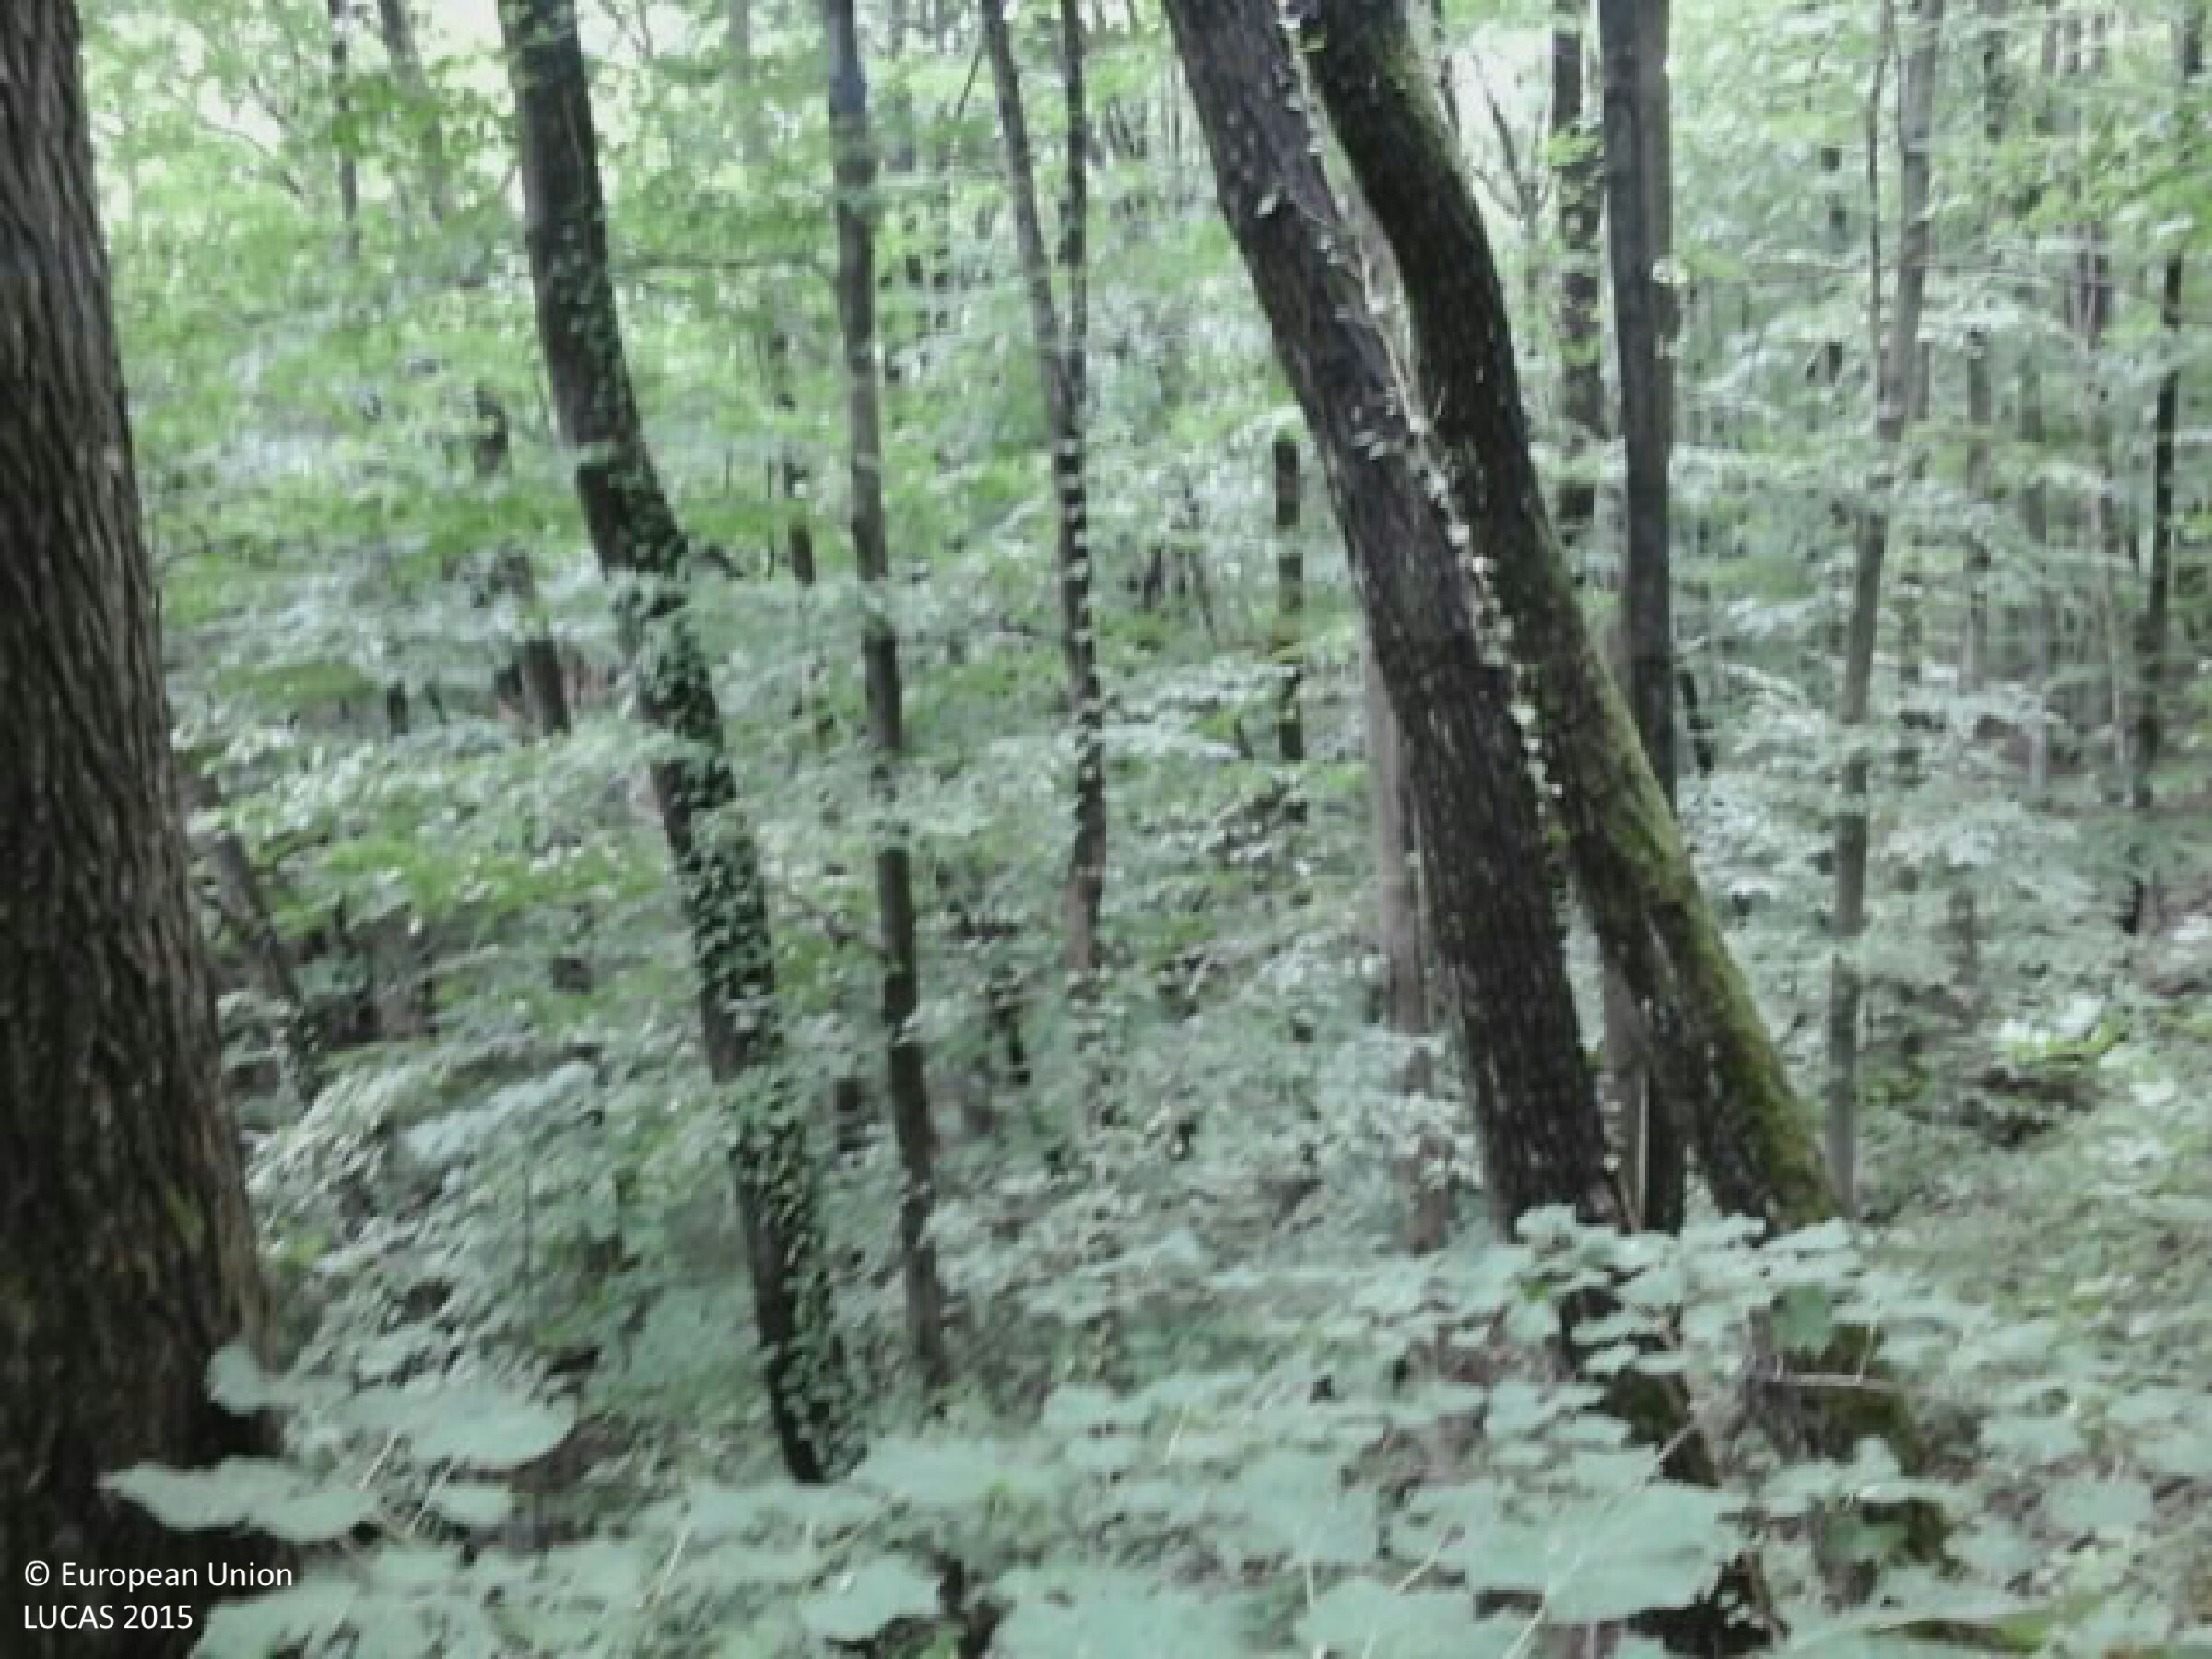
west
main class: Woodland
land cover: Broadleaved woodland
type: beech forest
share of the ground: > 75 %
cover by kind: broadleaved forest trees 90 %, herbaceous plants 10 %
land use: Forestry
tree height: > 5 m
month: July
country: HU
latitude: 46.1799
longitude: 17.9732
